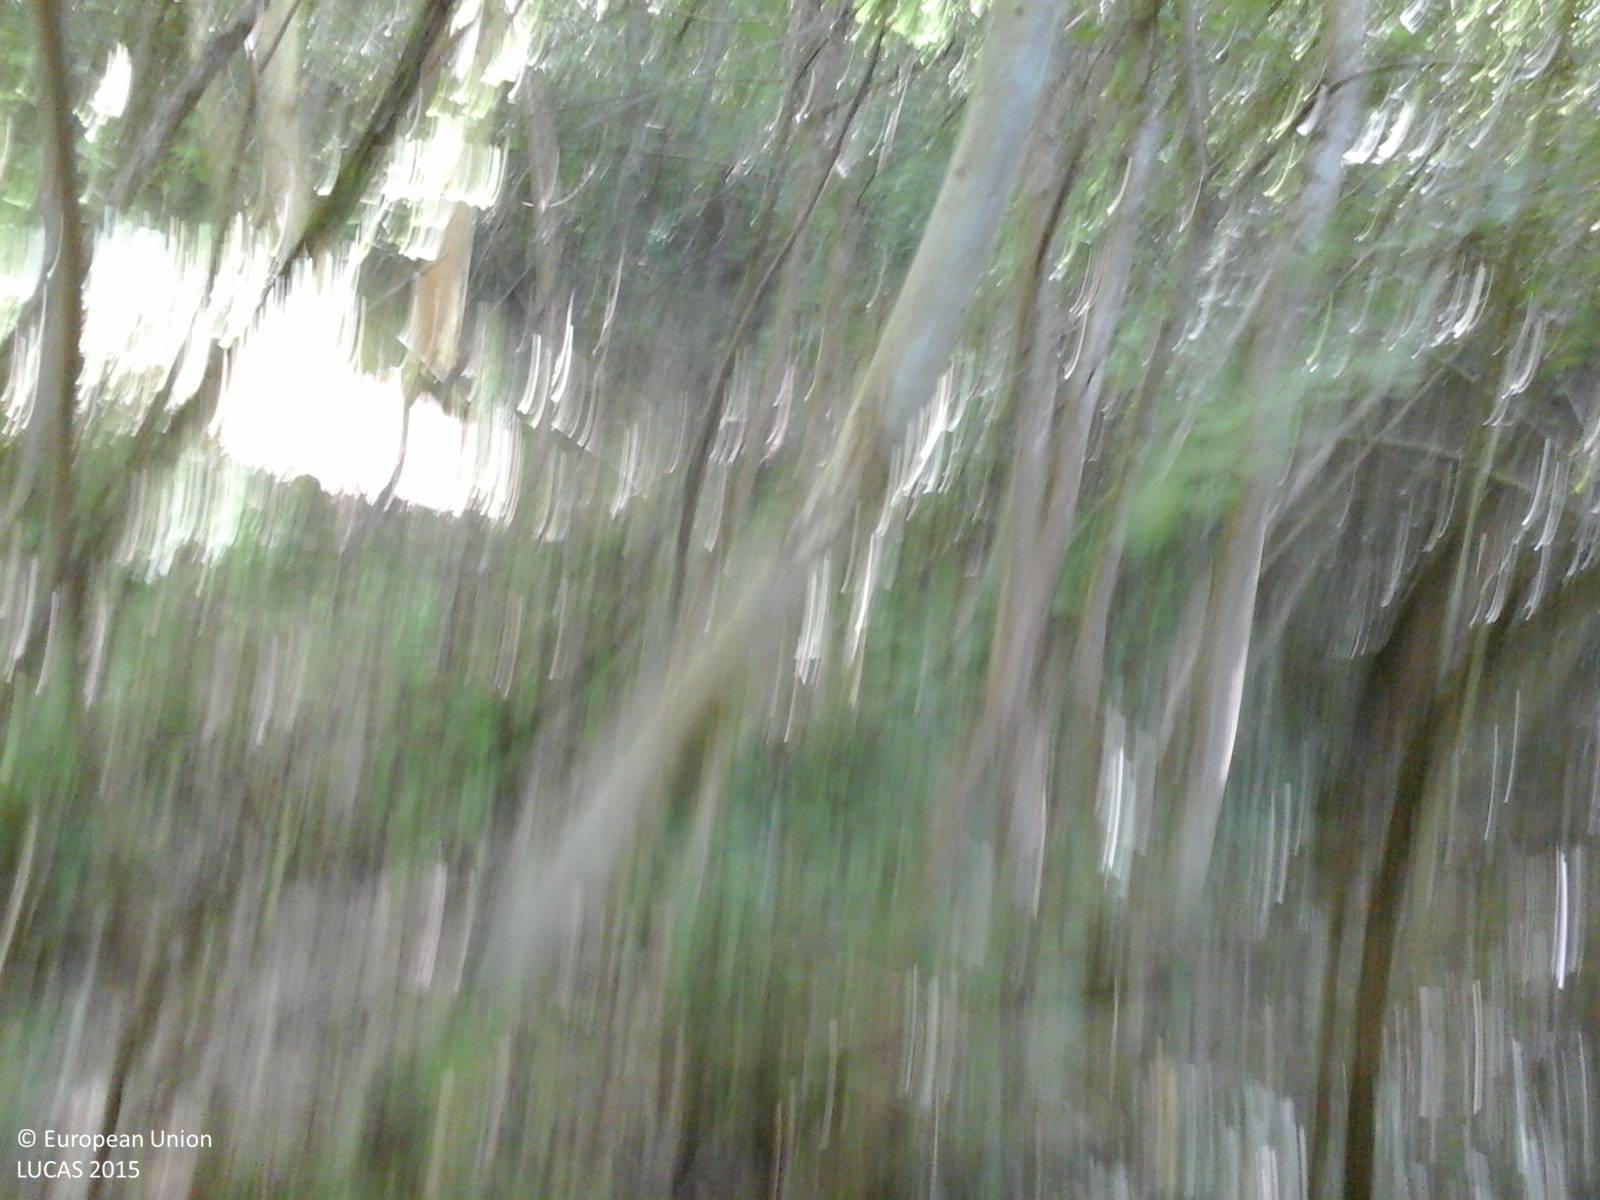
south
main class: Woodland
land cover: Broadleaved woodland
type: thermophilous deciduous forest
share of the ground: > 75 %
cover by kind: broadleaved forest trees 90 %, shrubs 10 %
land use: Forestry
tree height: > 5 m
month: June
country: IT
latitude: 42.4836
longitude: 12.2916
